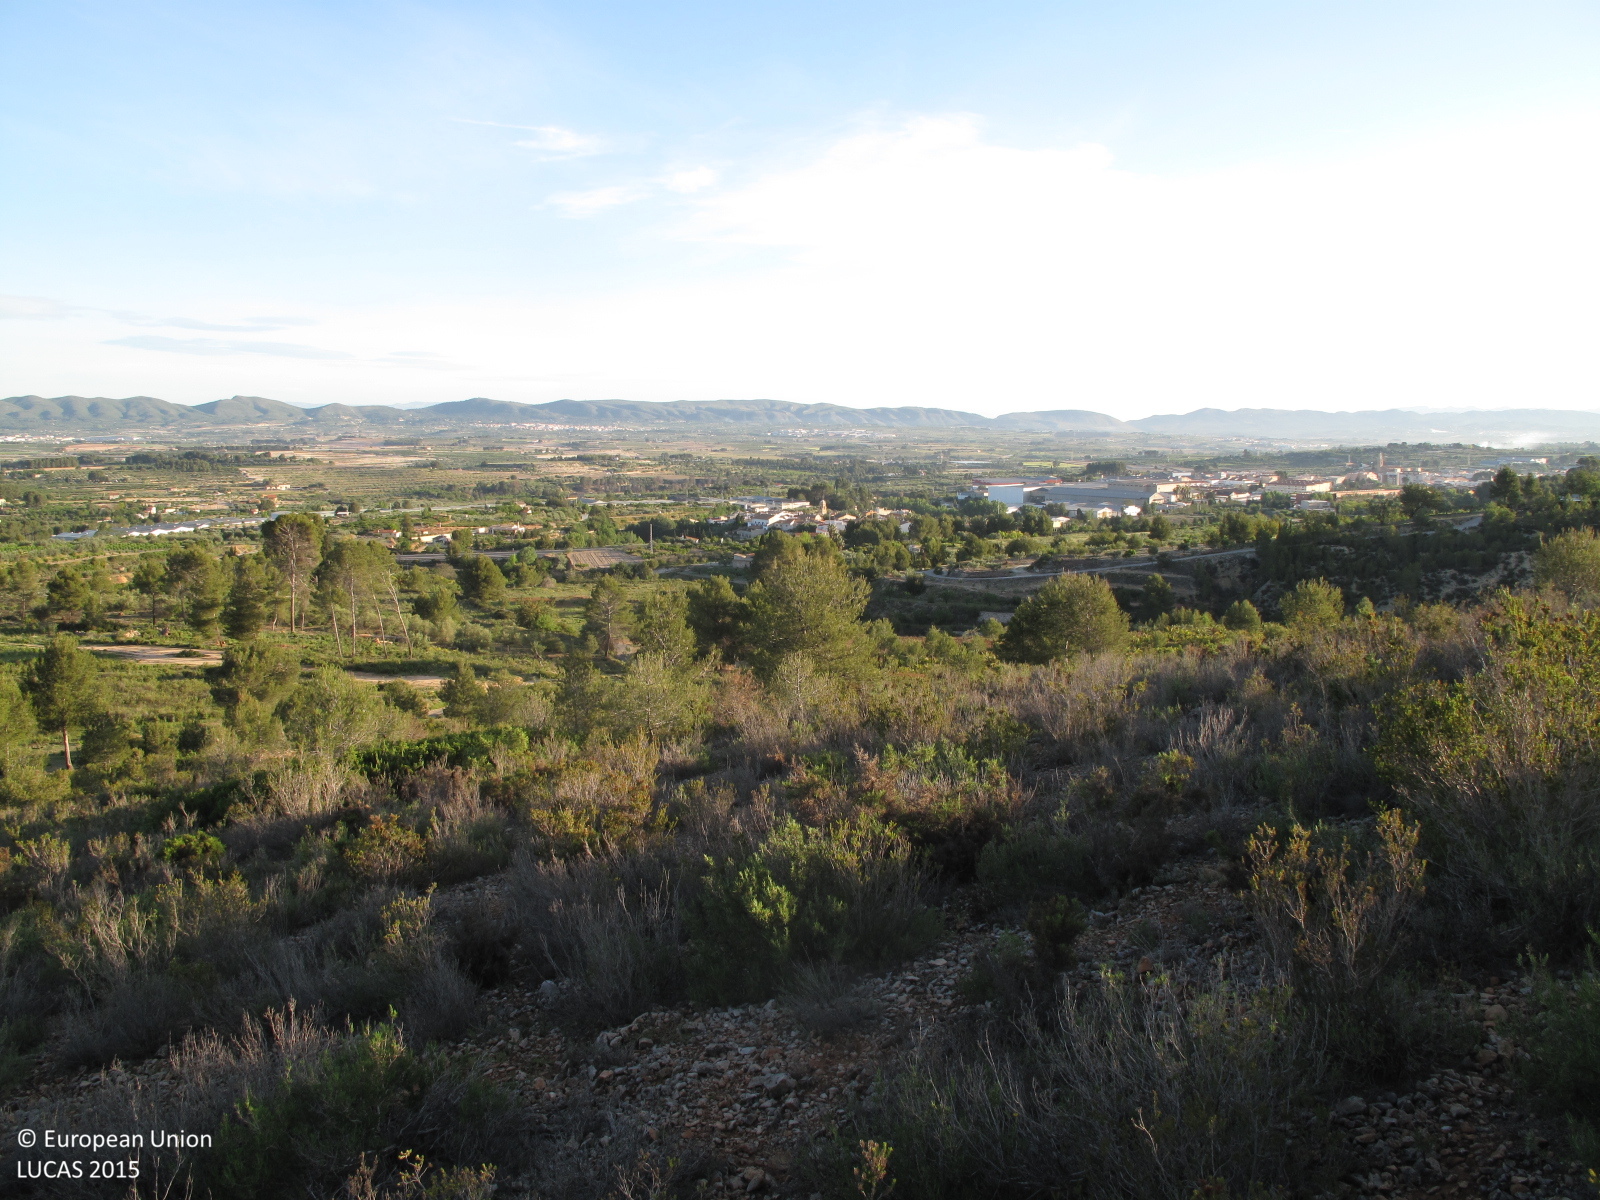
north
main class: Shrubland
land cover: Shrubland with sparse tree cover
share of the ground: > 75 %
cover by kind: shrubs 75 %, herbaceous plants 10 %, lichens and mosses 10 %, coniferous forest trees 5 %
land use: Semi-natural and natural areas not in use
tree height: > 5 m
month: May
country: ES
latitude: 38.8234
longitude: -0.5300
